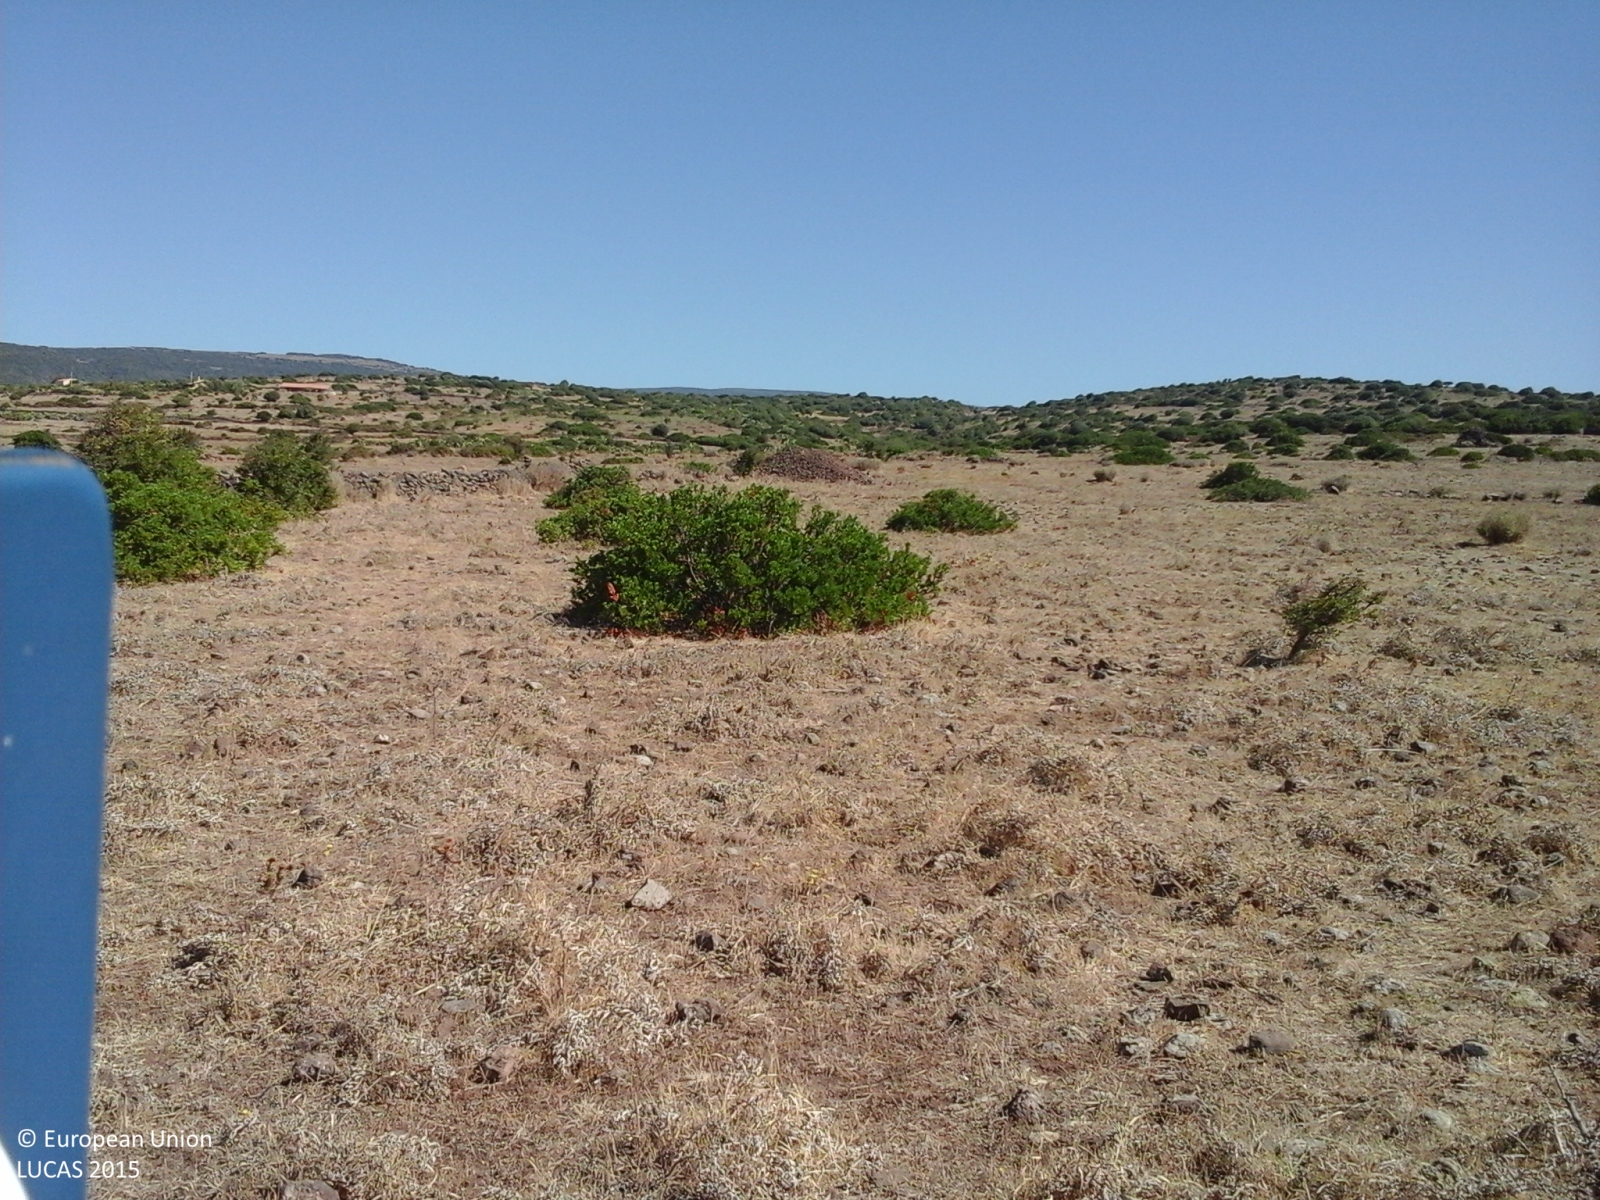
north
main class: Grassland
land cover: Grassland without tree/shrub cover
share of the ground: > 75 %
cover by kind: herbaceous plants 100 %
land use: Agriculture (excluding fallow land and kitchen gardens)
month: August
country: IT
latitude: 40.0399
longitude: 8.5895
